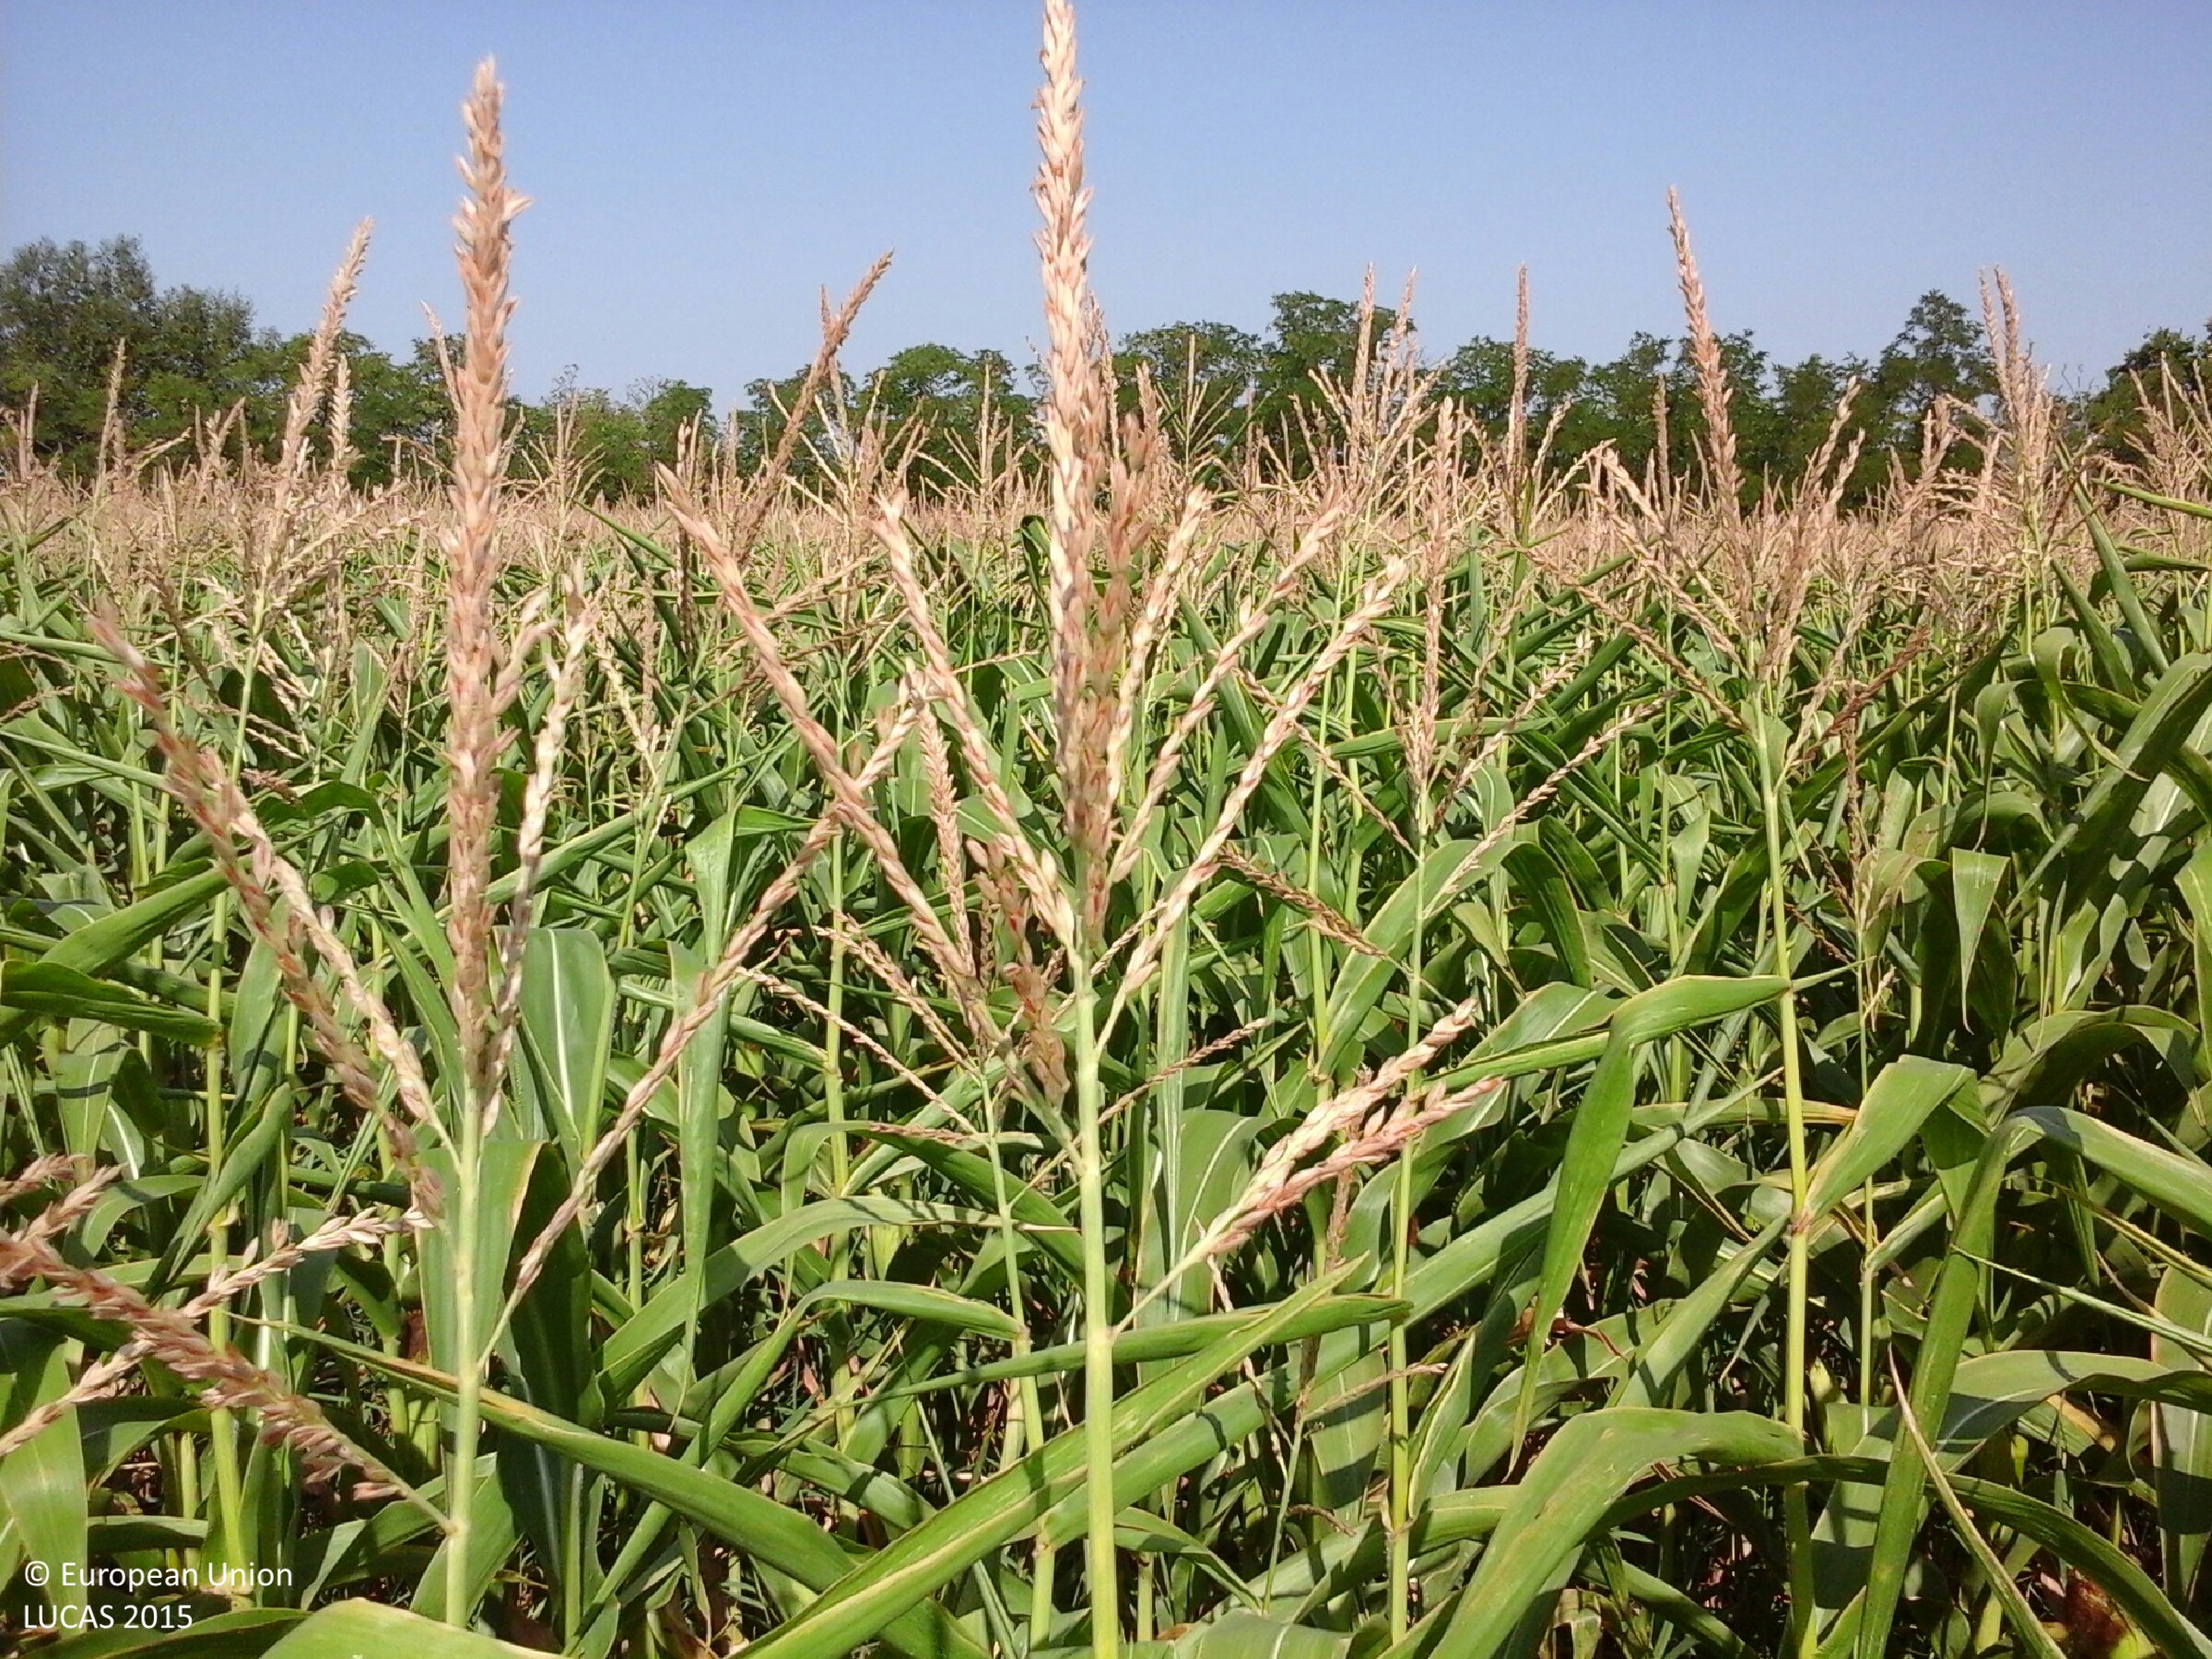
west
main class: Cropland
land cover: Maize
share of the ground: > 75 %
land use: Agriculture (excluding fallow land and kitchen gardens)
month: July
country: HU
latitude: 47.6422
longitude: 20.5614
